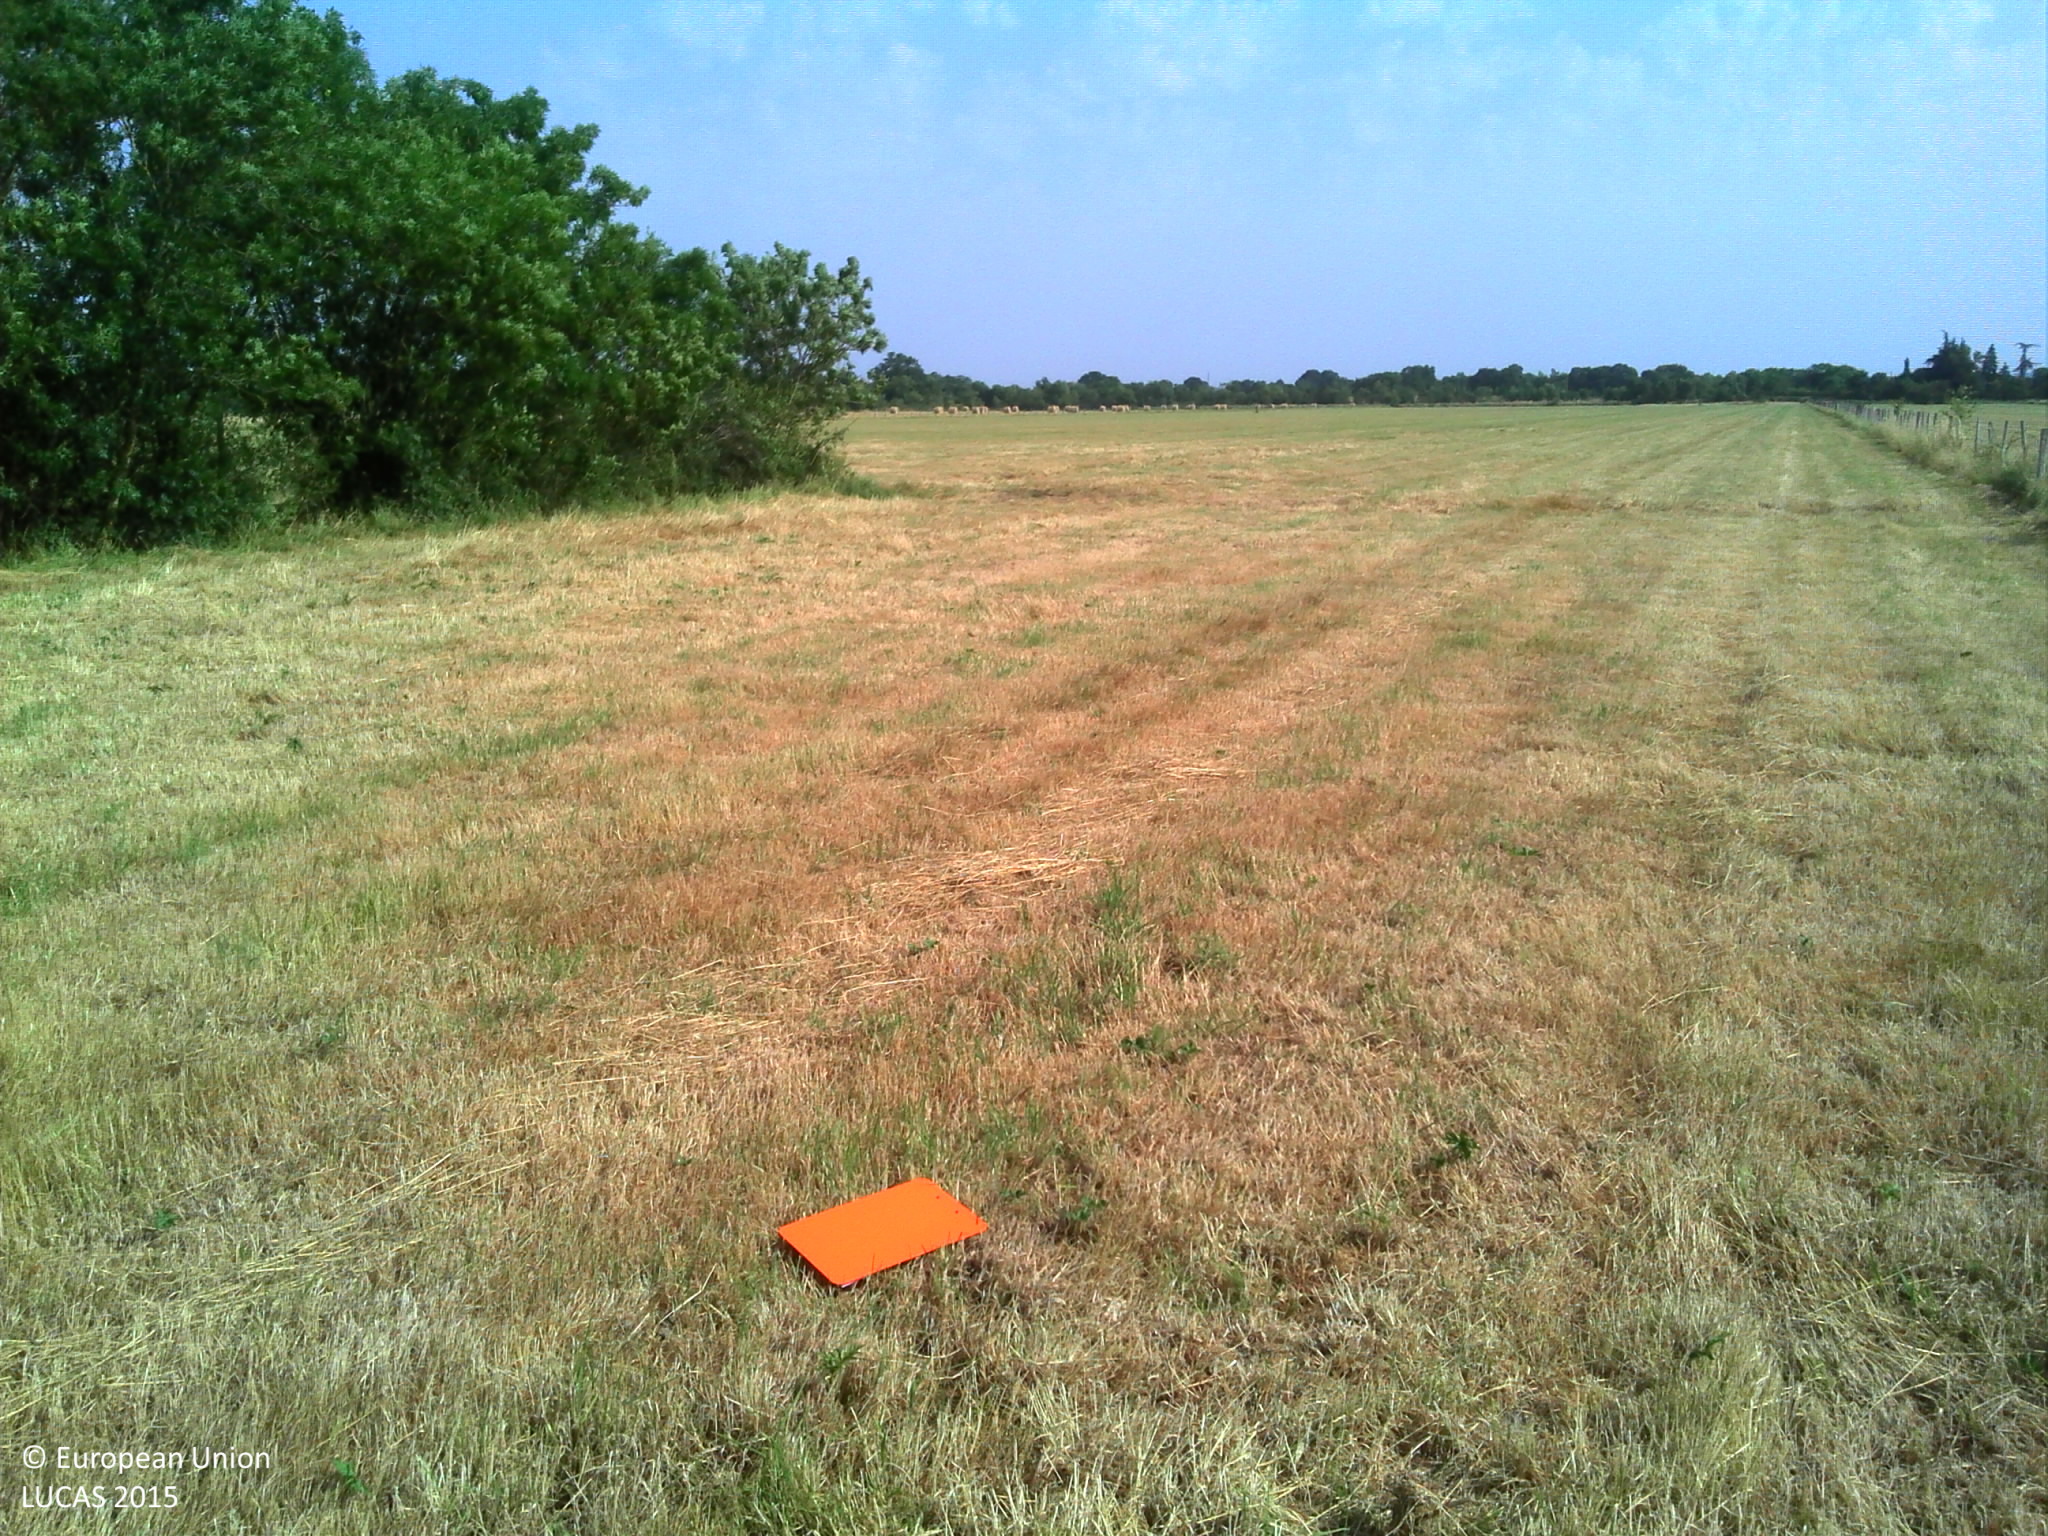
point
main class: Grassland
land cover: Grassland without tree/shrub cover
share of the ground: > 75 %
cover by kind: herbaceous plants 100 %
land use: Agriculture (excluding fallow land and kitchen gardens)
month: July
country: FR
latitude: 47.3114
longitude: -1.9934
